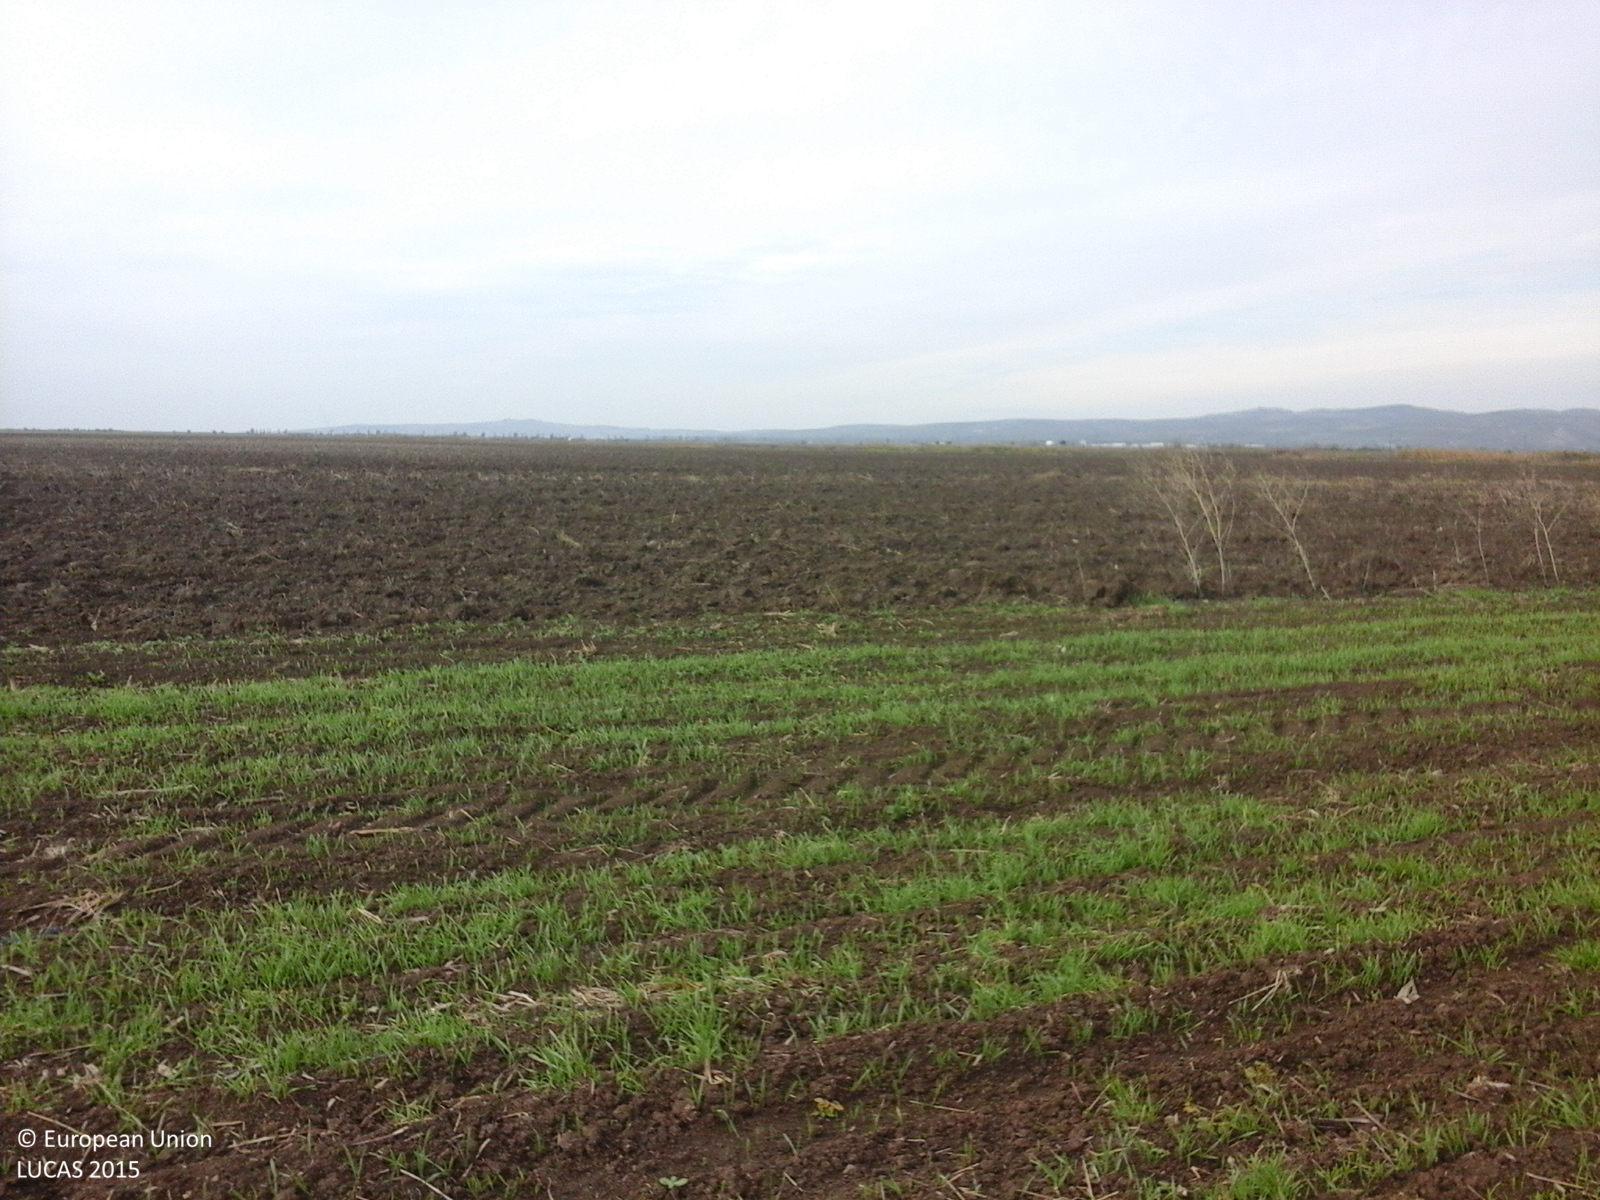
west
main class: Cropland
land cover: Common wheat
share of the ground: 50 - 75 %
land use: Agriculture (excluding fallow land and kitchen gardens)
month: October
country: RO
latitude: 44.9842
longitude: 26.3892
